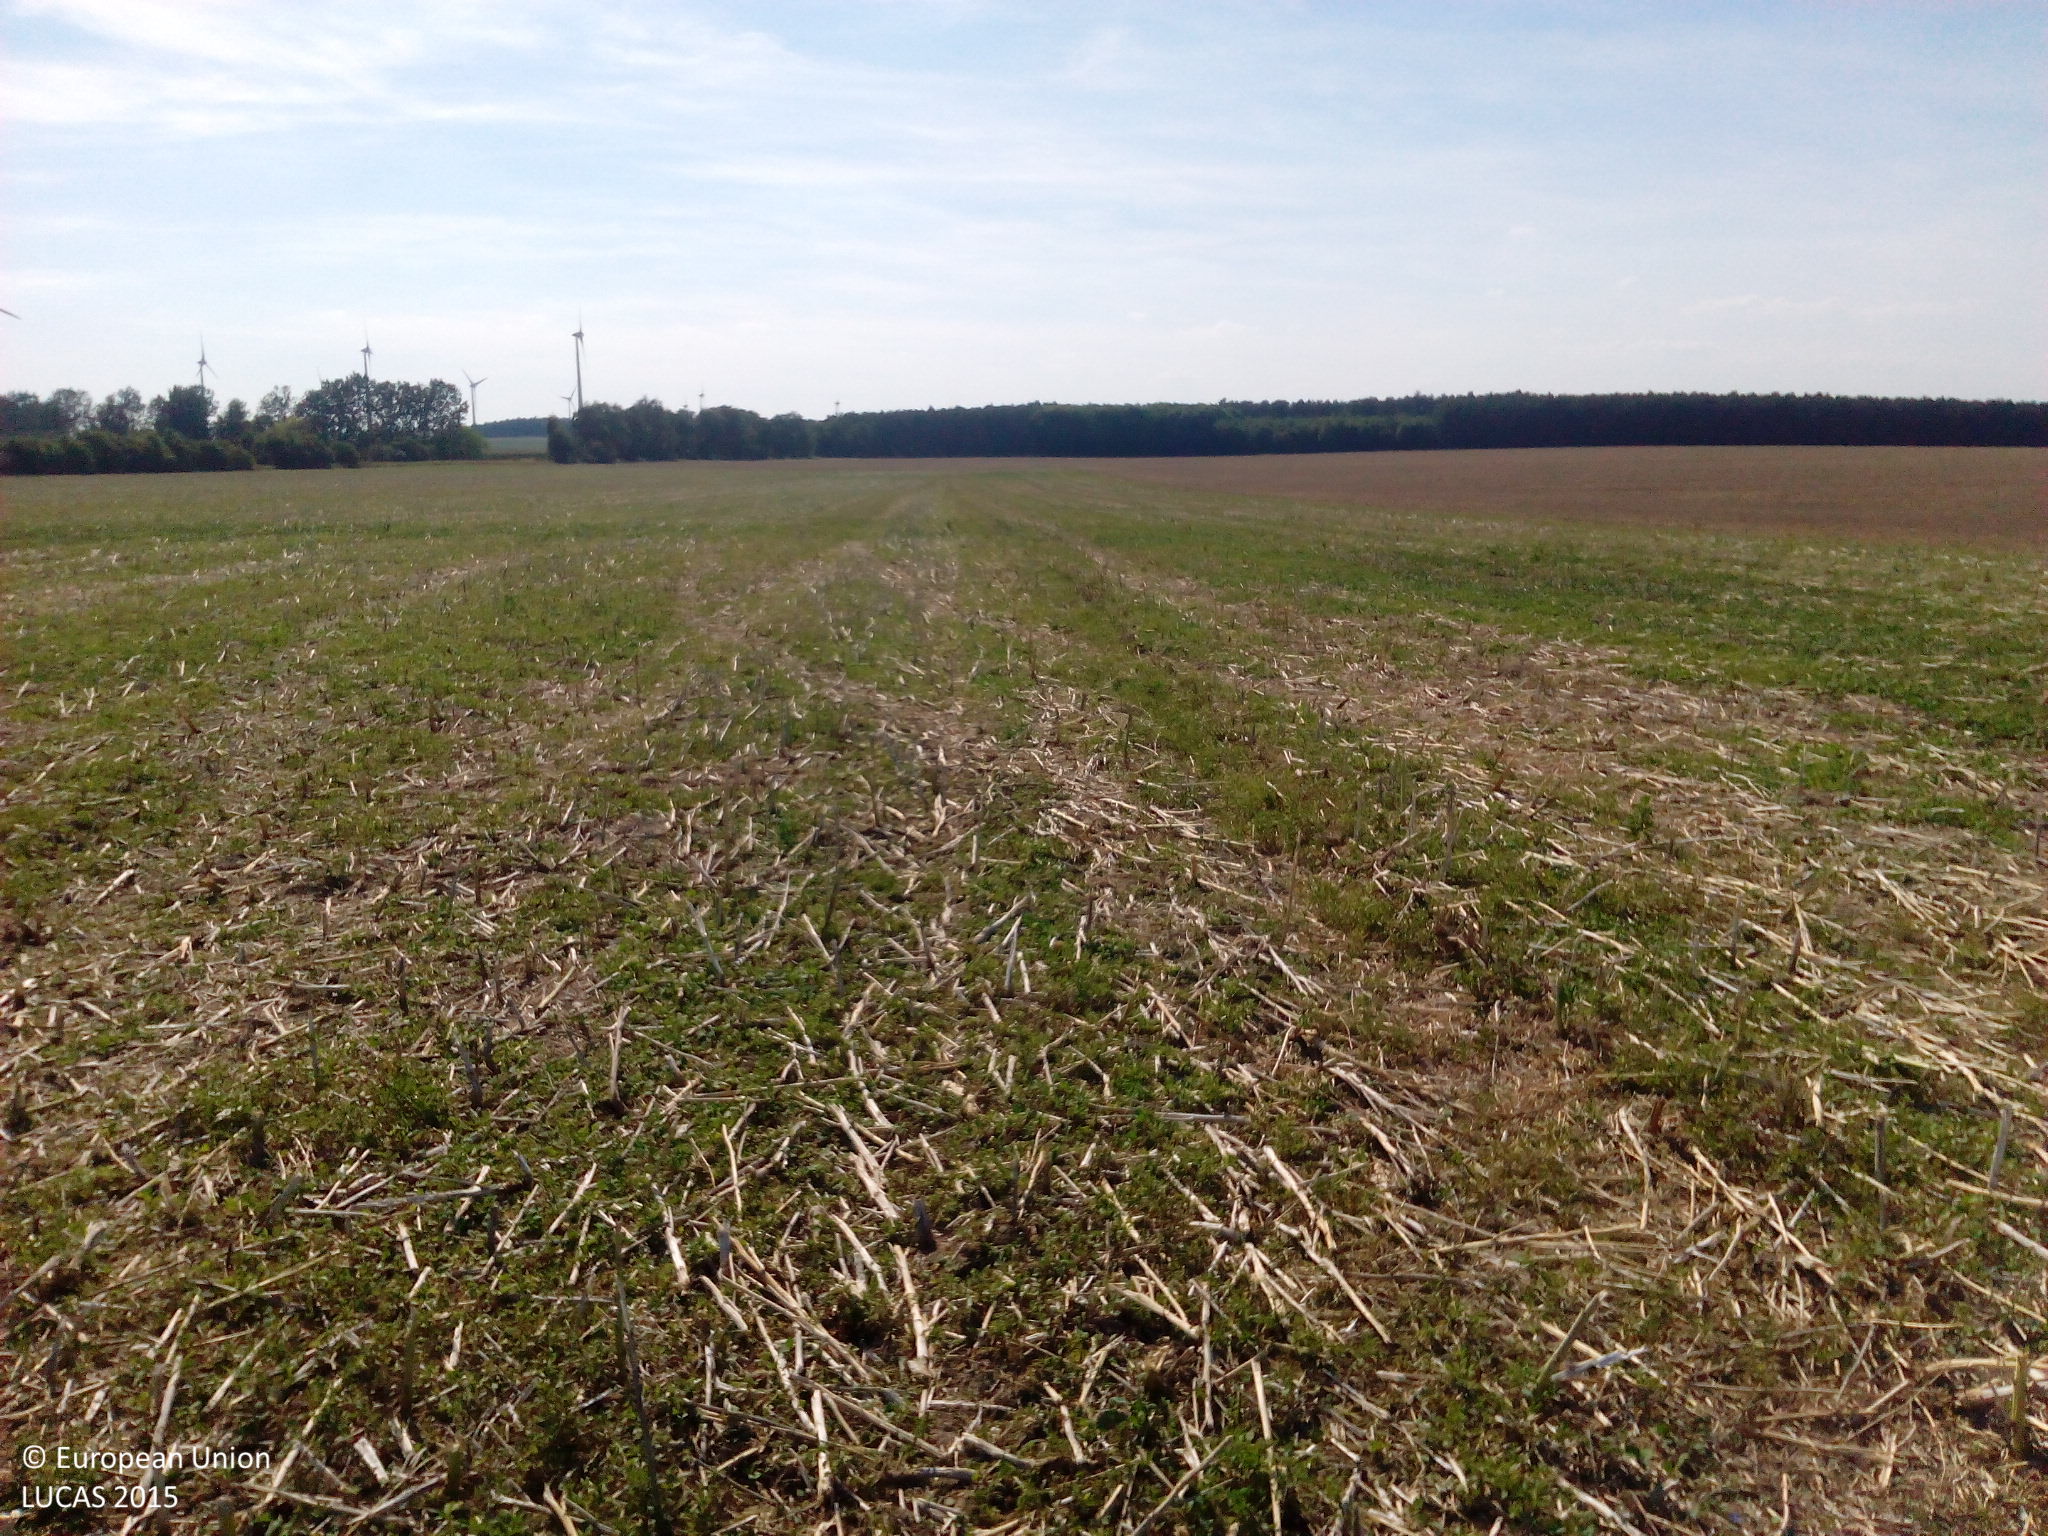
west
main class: Cropland
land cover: Rape and turnip rape
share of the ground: 10 - 25 %
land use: Agriculture (excluding fallow land and kitchen gardens)
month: August
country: DE
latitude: 51.9757
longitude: 13.1591
